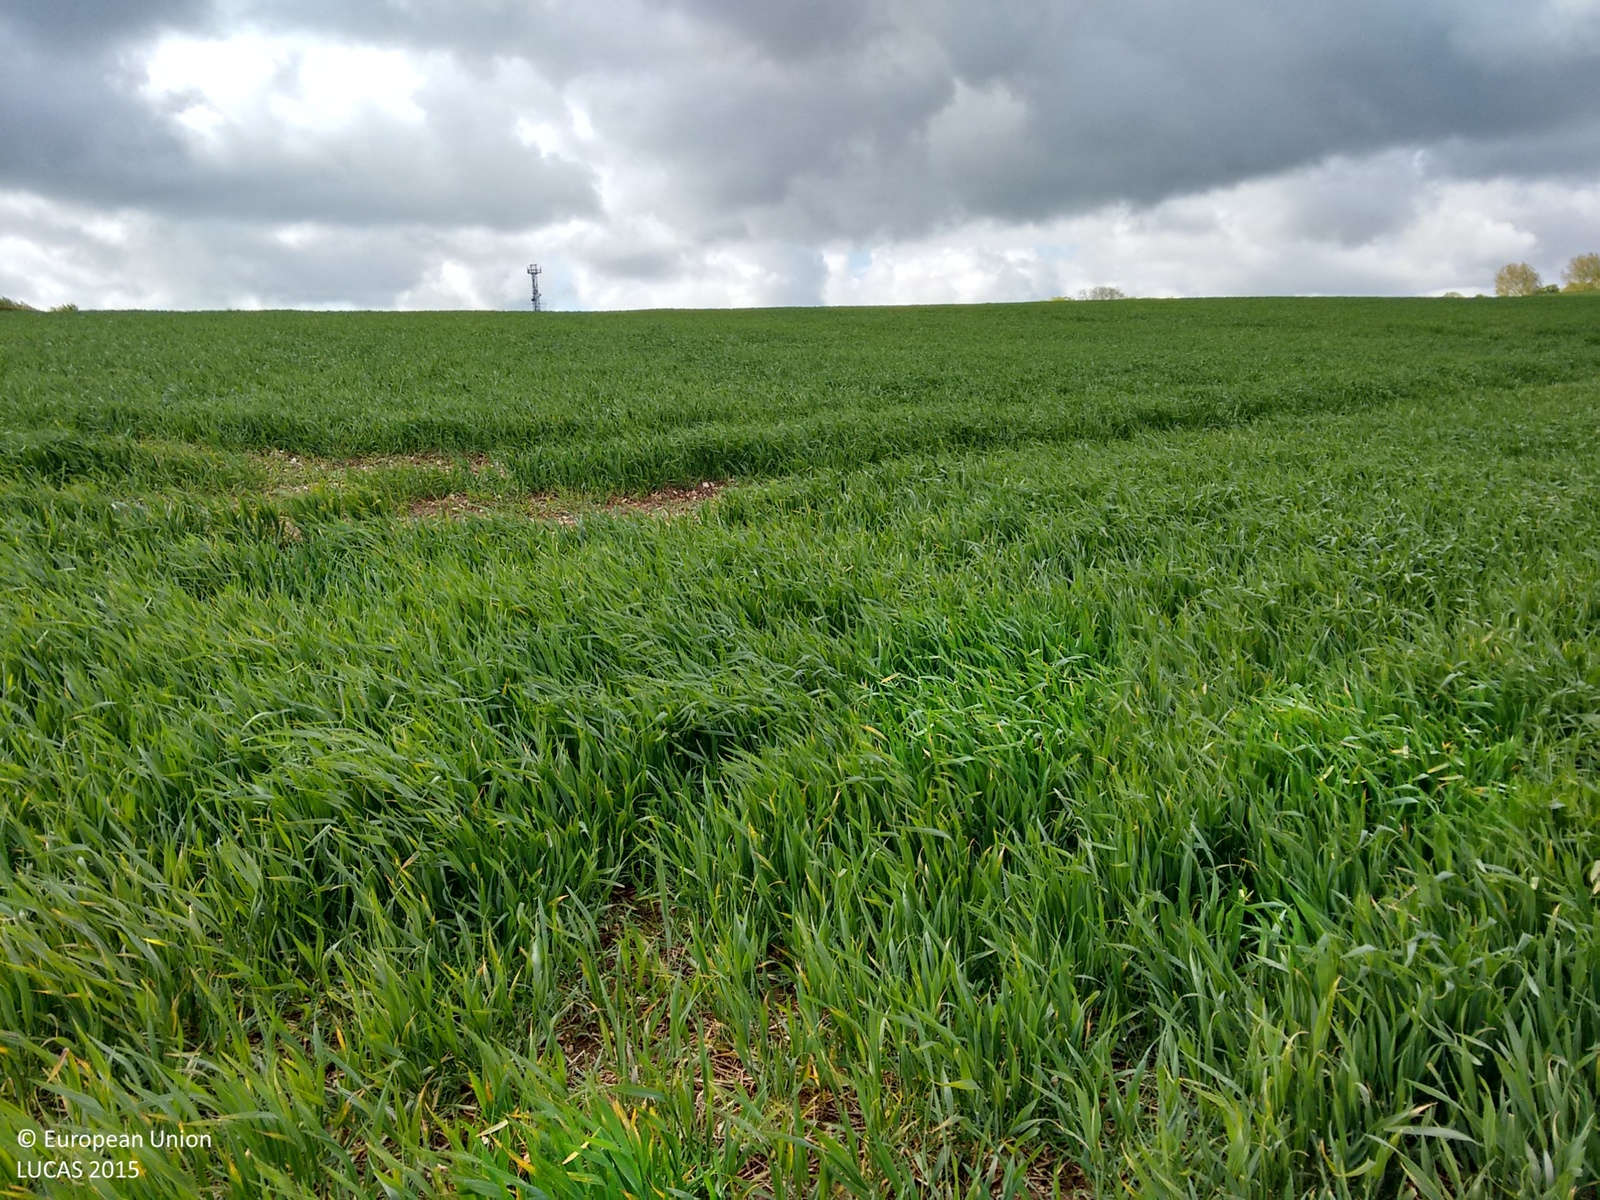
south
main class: Cropland
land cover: Common wheat
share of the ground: > 75 %
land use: Agriculture (excluding fallow land and kitchen gardens)
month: May
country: GB
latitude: 53.3985
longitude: -0.0638
